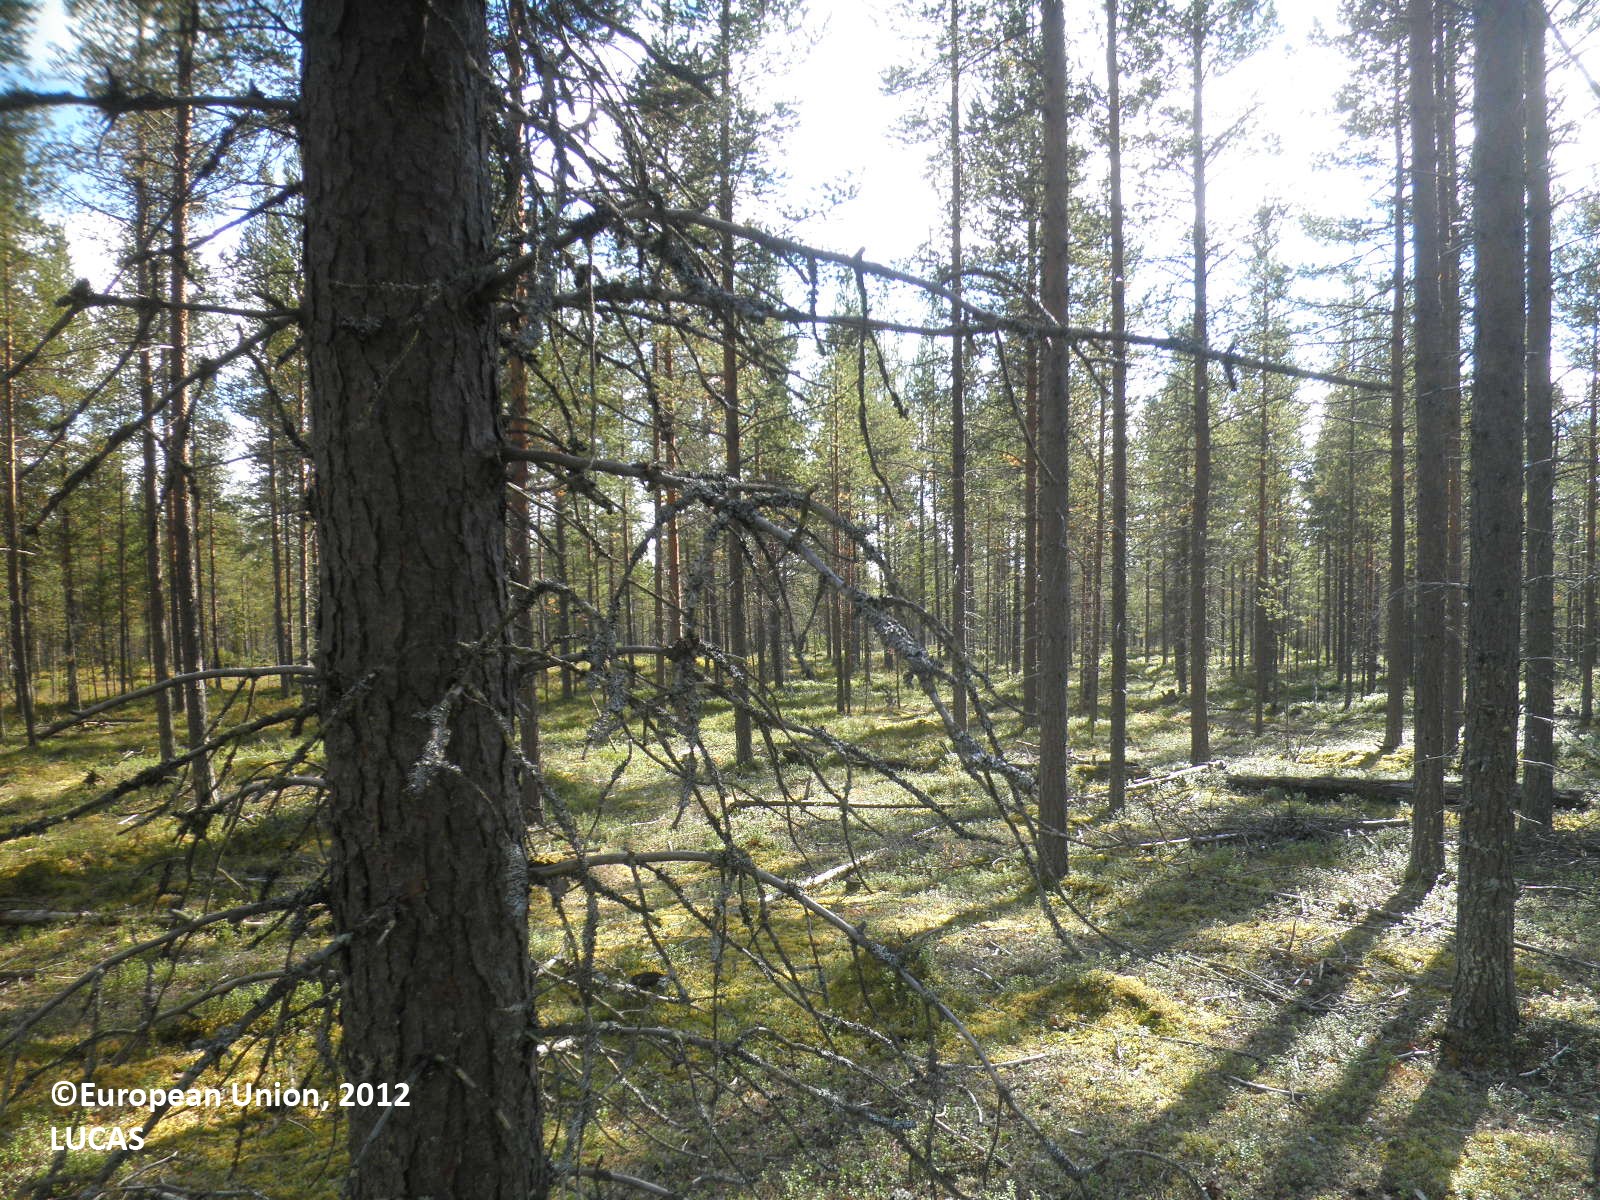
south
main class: Woodland
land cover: Pine dominated coniferous woodland
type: boreal forest
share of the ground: 50 - 75 %
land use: Forestry
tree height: > 5 m
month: August
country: FI
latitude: 67.6212
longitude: 28.6547
